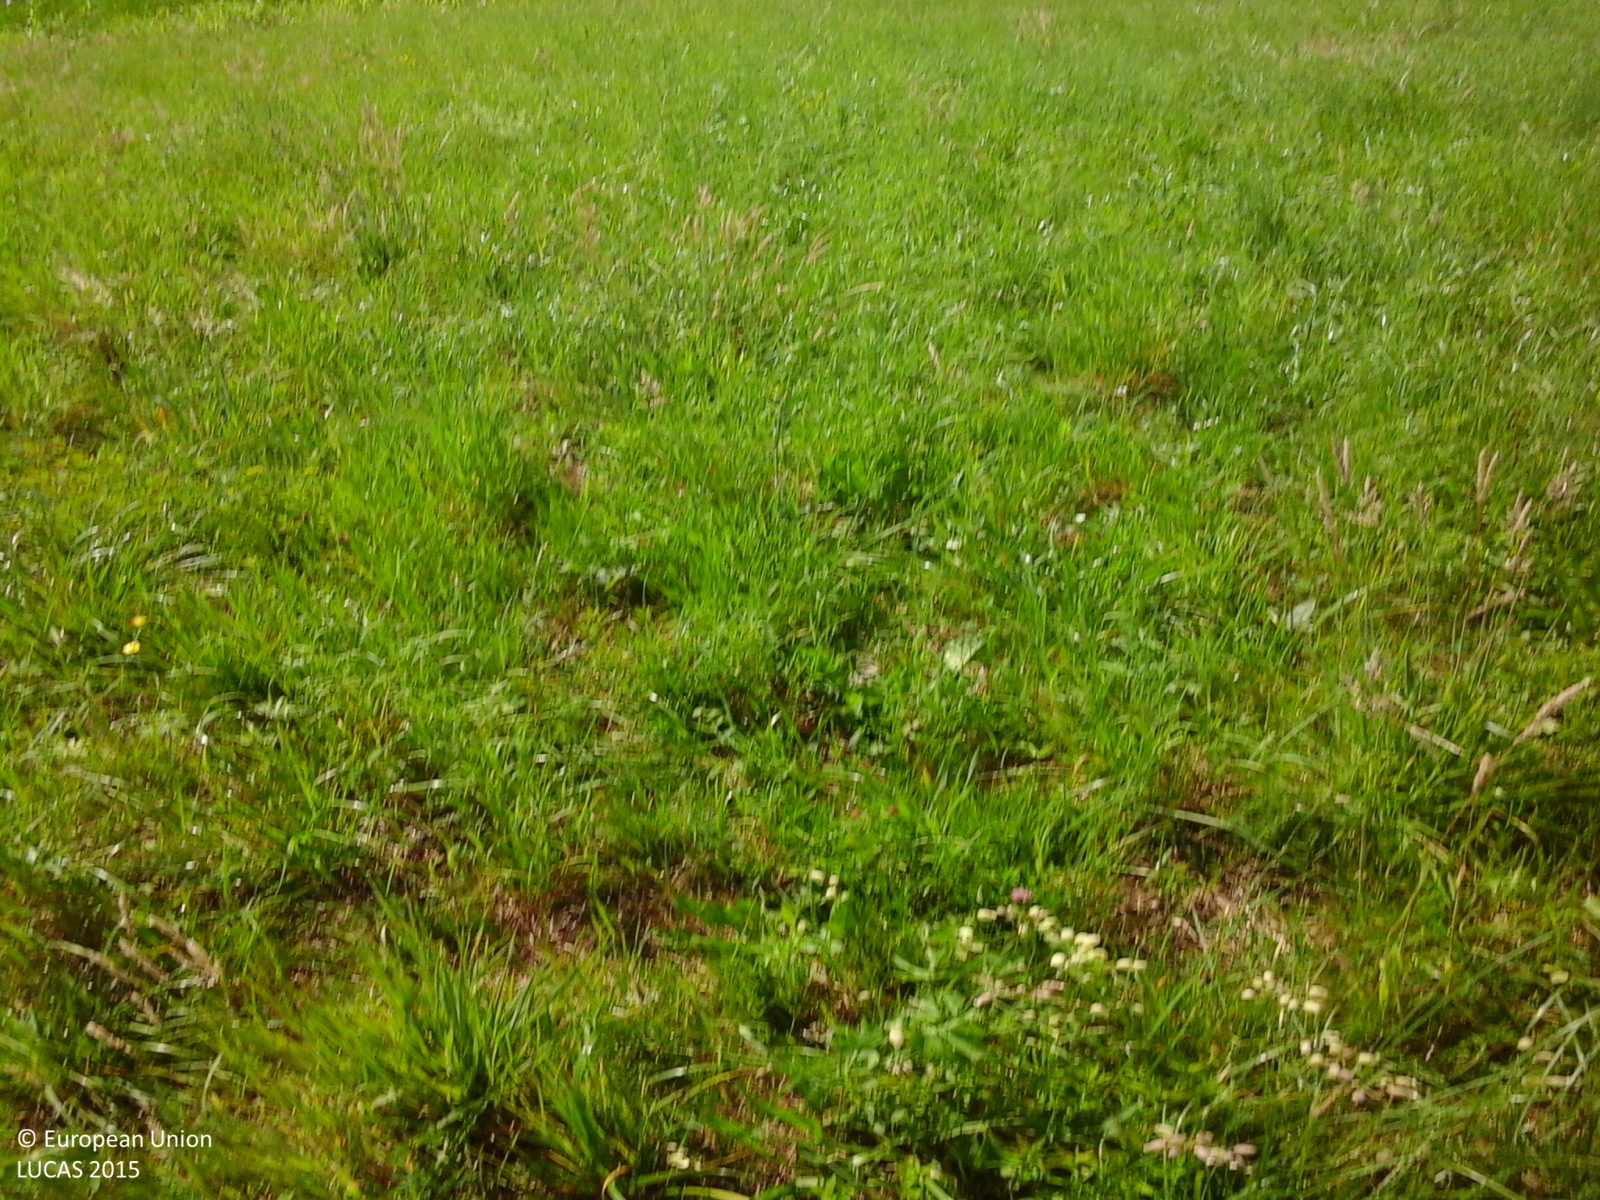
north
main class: Grassland
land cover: Grassland without tree/shrub cover
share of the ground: > 75 %
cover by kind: herbaceous plants 100 %
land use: Agriculture (excluding fallow land and kitchen gardens)
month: June
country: IT
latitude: 45.9293
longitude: 12.3310
